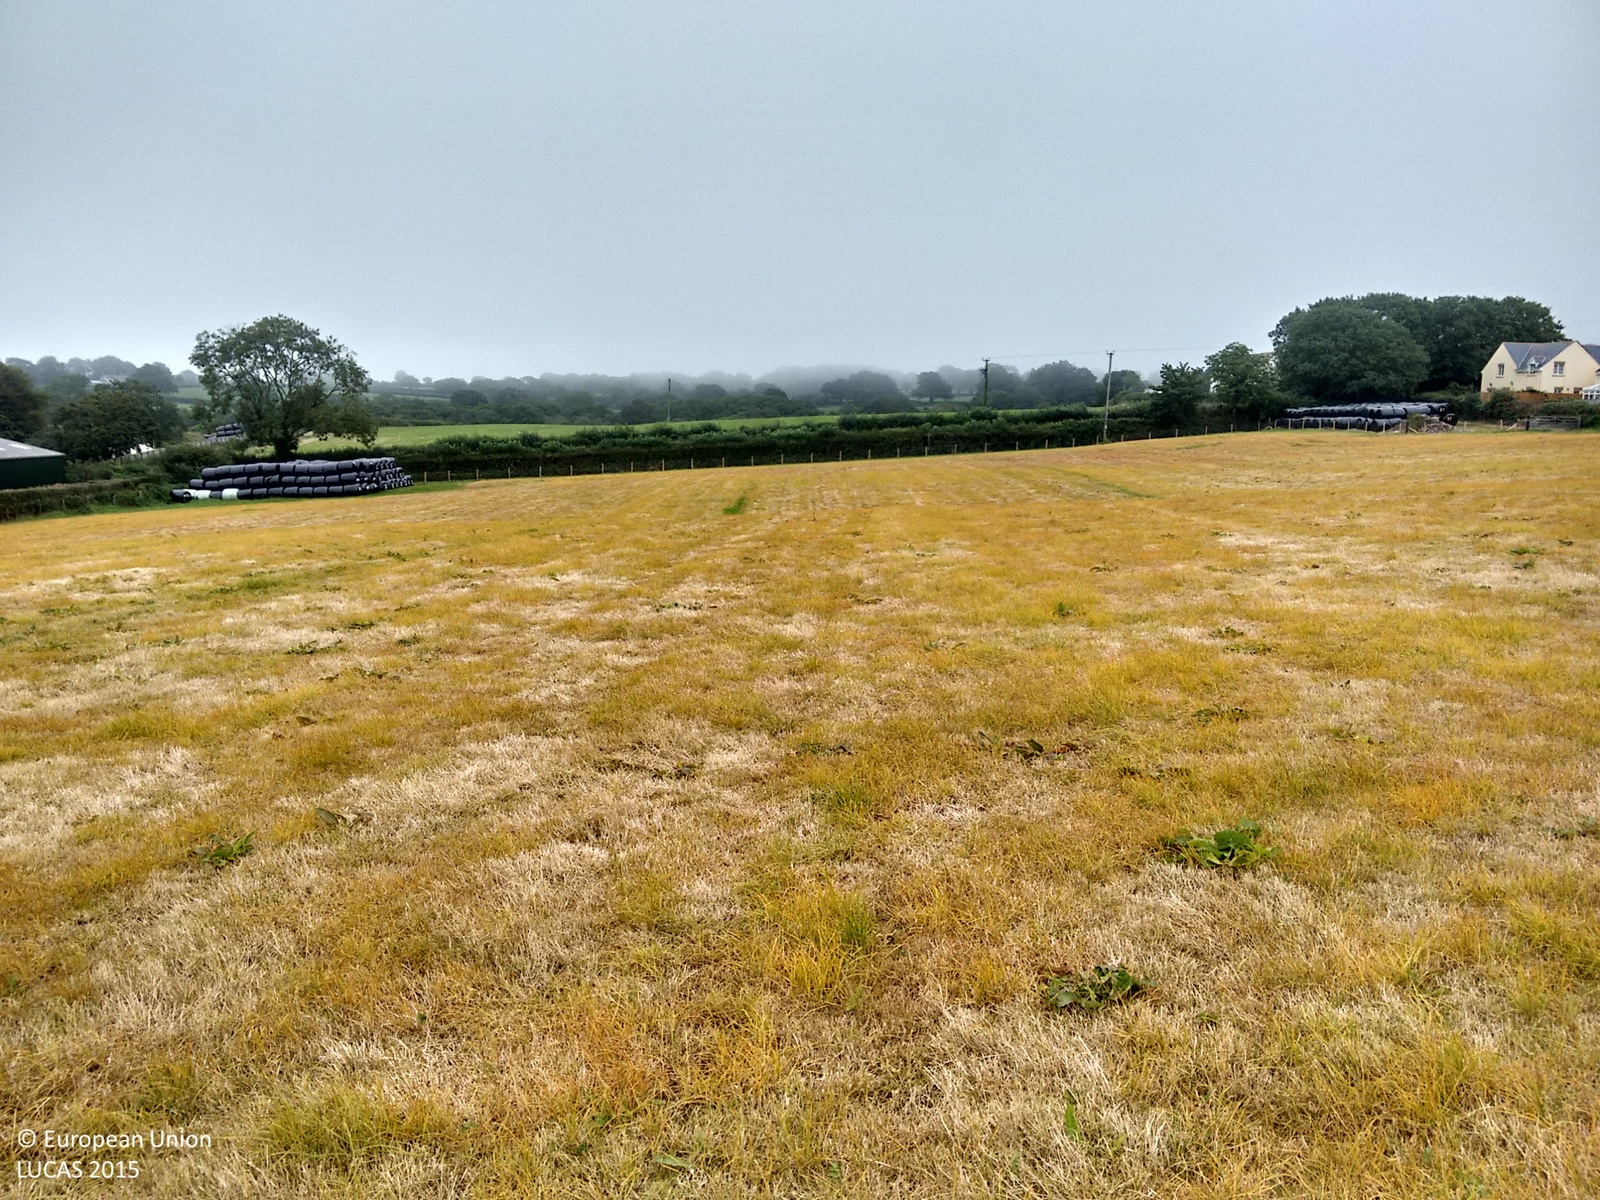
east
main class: Grassland
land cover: Grassland without tree/shrub cover
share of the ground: > 75 %
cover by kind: herbaceous plants 100 %
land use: Agriculture (excluding fallow land and kitchen gardens)
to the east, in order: Grassland without tree/shrub cover; Fences; Ditches and canals; Managed hedges; Ditches and canals; Grass margins; Paved roads, cycling and walking lanes; Grass margins; Ditches and canals; Managed hedges; Grassland without tree/shrub cover; Electric lines; Grassland without tree/shrub cover
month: August
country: GB
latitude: 51.7836
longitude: -4.7076
